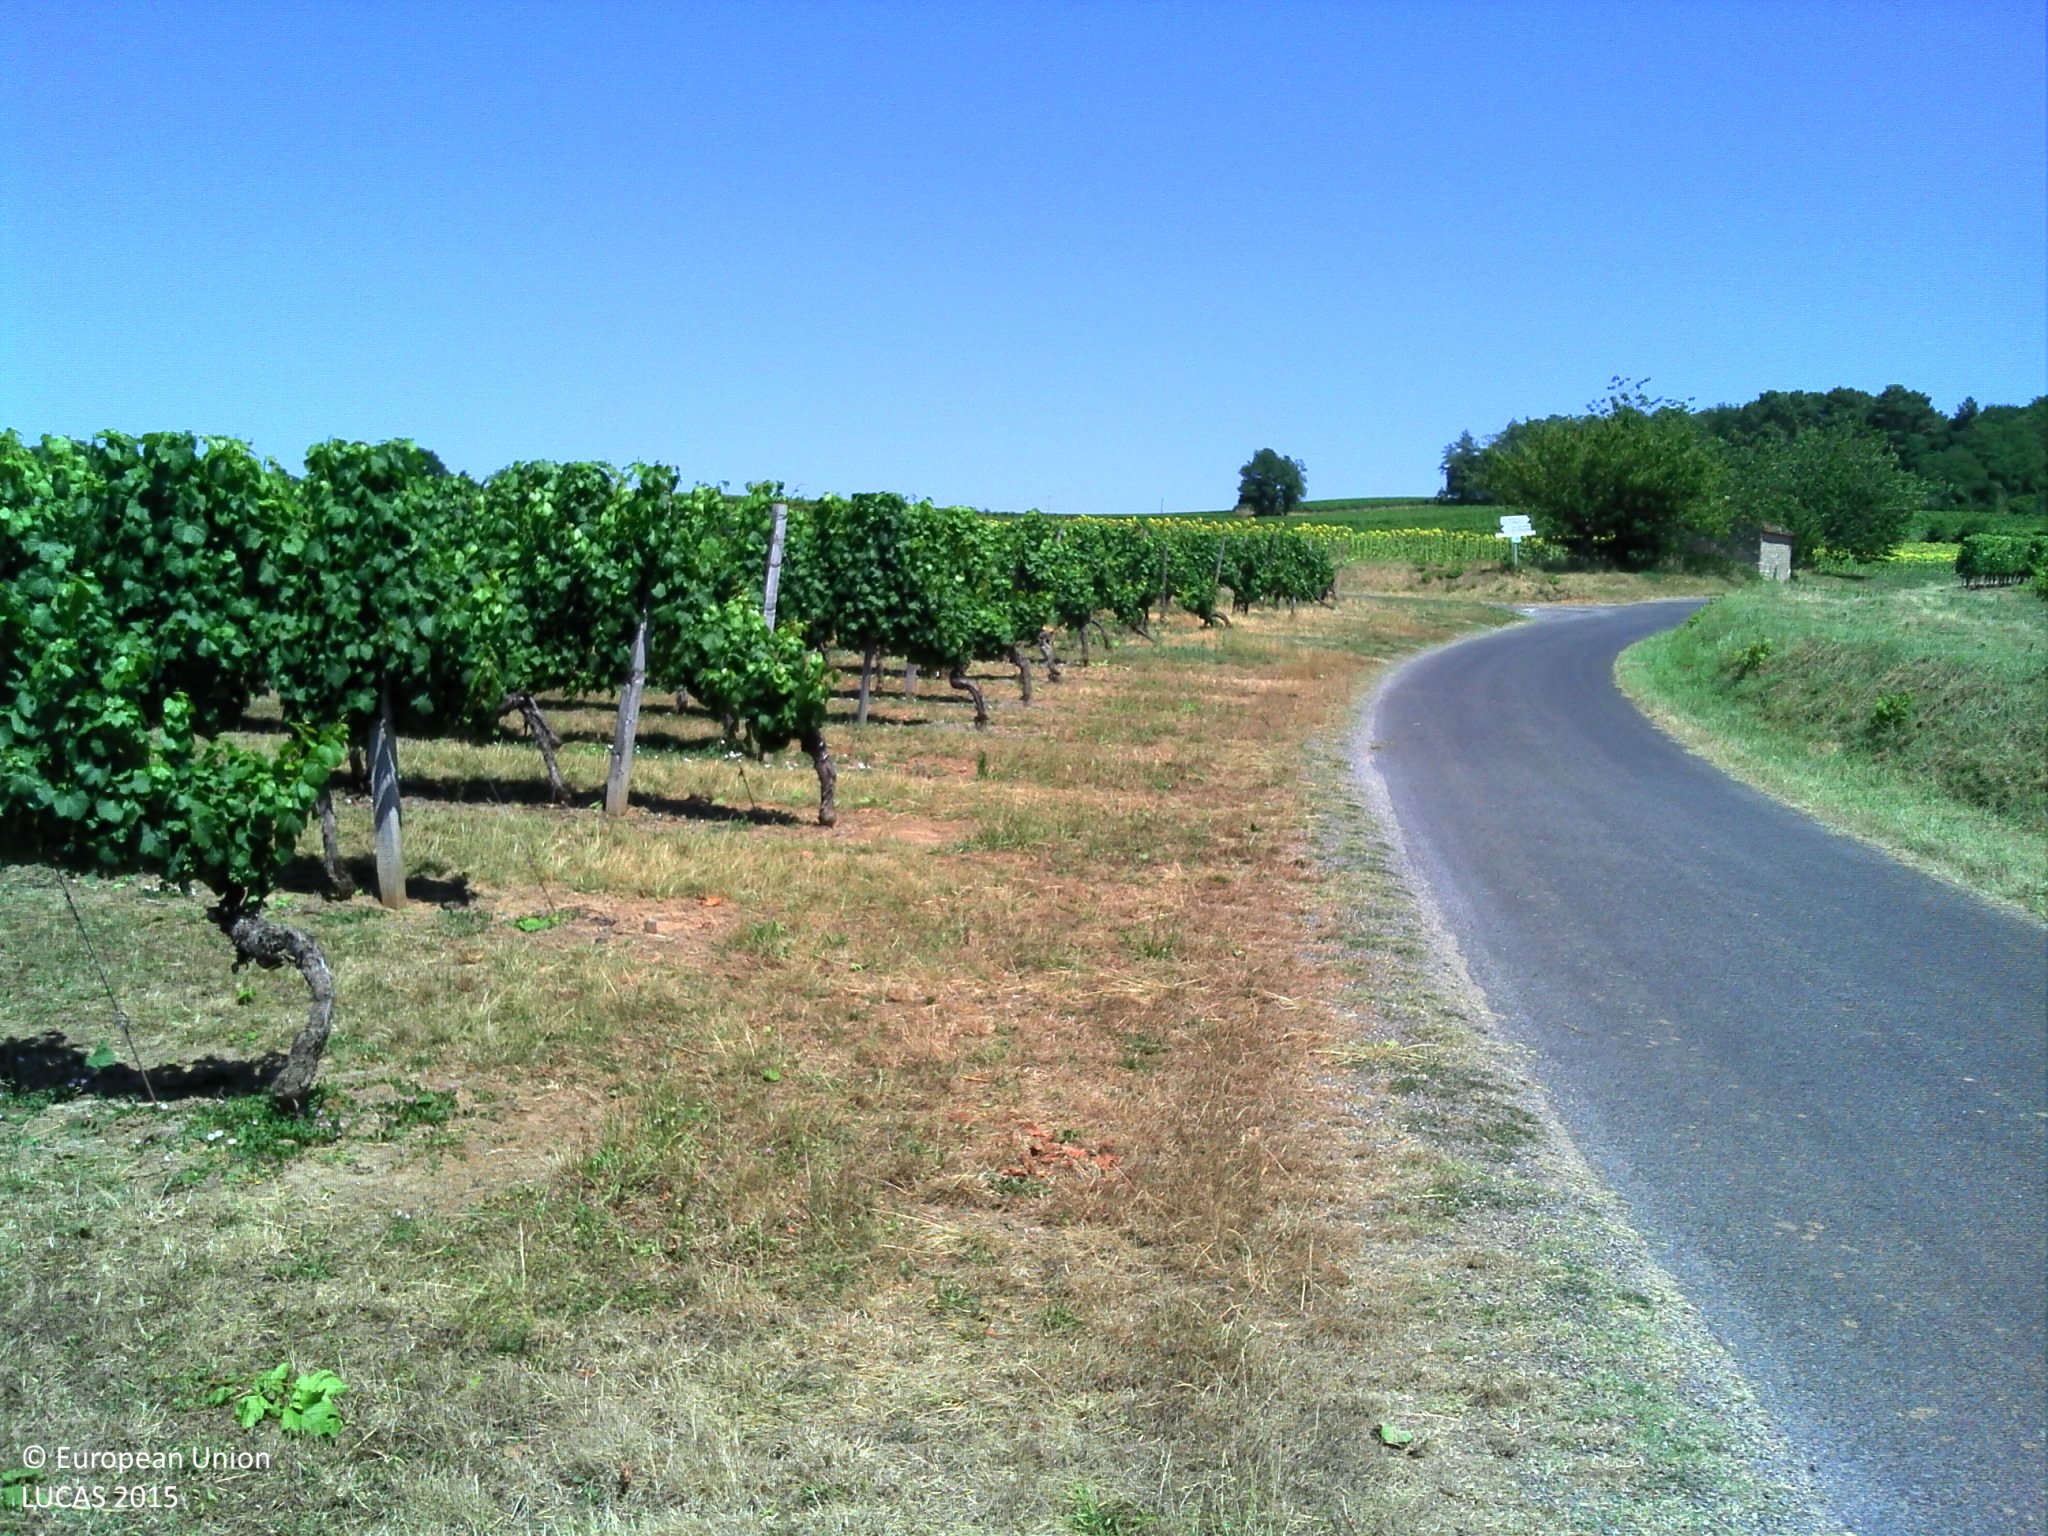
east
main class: Cropland
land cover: Vineyards
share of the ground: > 75 %
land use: Agriculture (excluding fallow land and kitchen gardens)
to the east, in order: Vineyards; Grass margins; Paved roads, cycling and walking lanes; Grass margins; Lines of trees; Grass margins; Sunflower; Tracks; Managed hedges; Vineyards; Grassland without tree/shrub cover
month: July
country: FR
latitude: 44.4845
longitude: 1.2077
